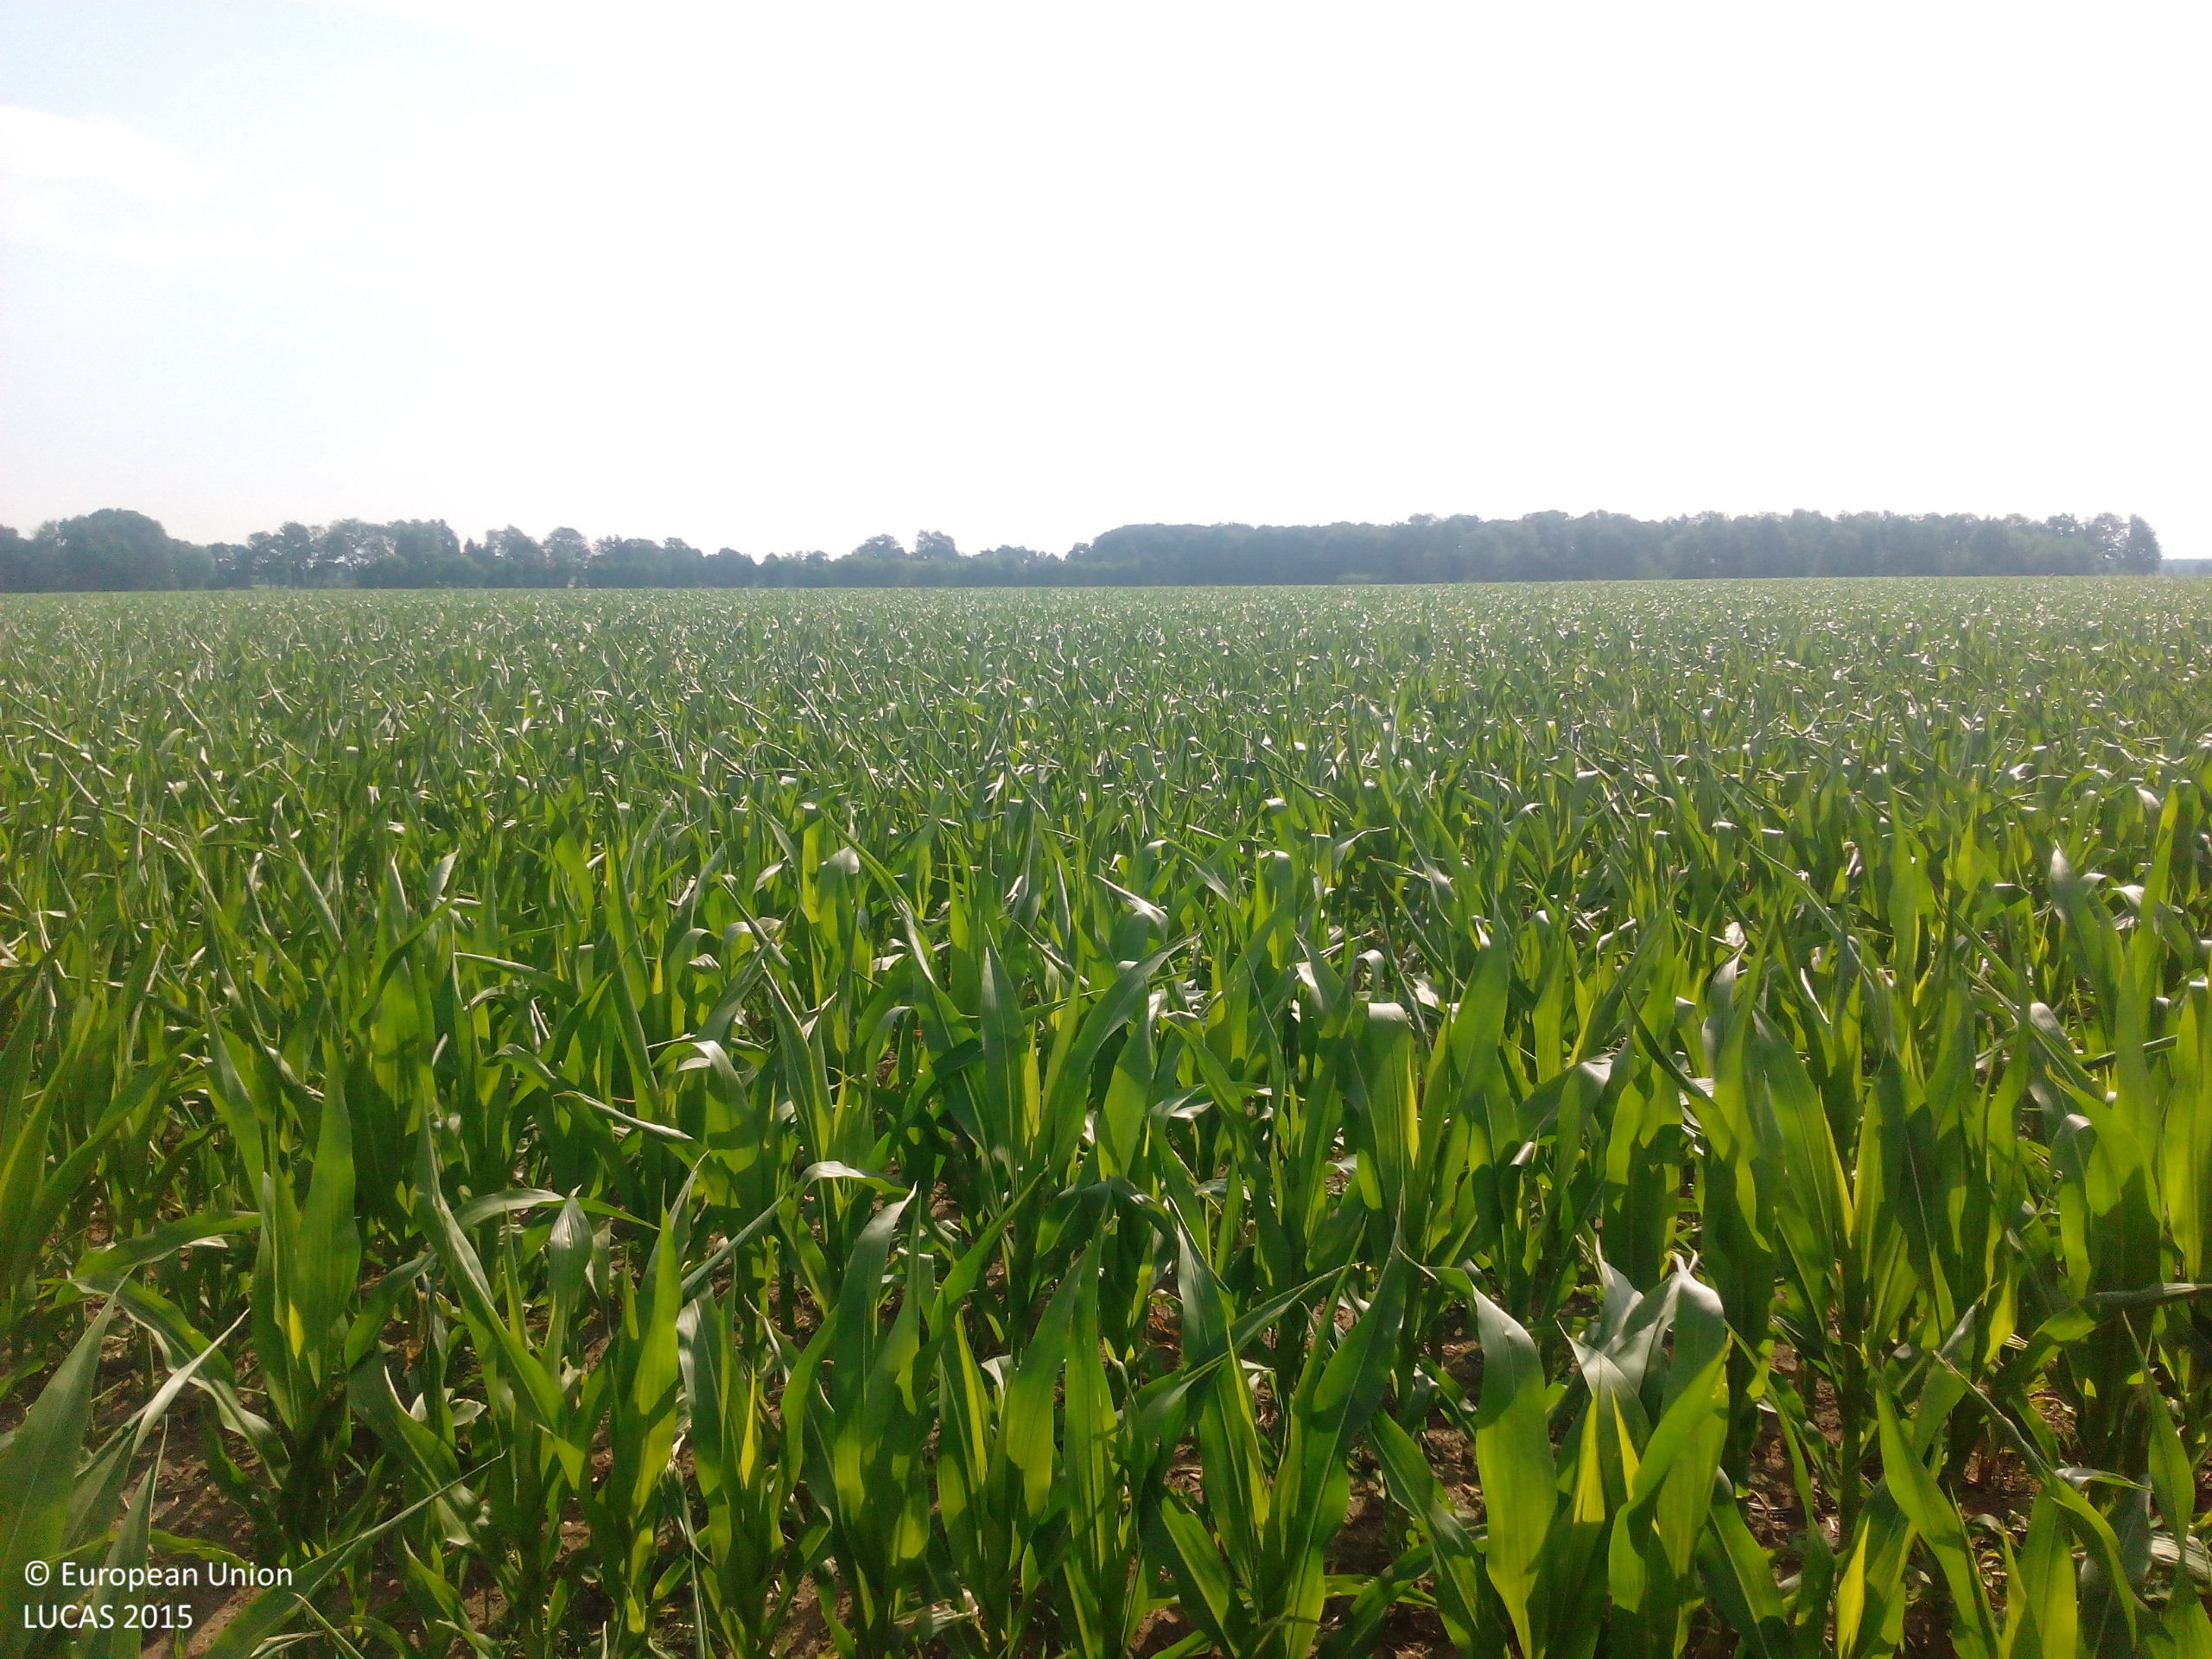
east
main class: Cropland
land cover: Maize
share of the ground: > 75 %
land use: Agriculture (excluding fallow land and kitchen gardens)
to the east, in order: Maize
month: July
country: DE
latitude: 52.5338
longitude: 11.1348
